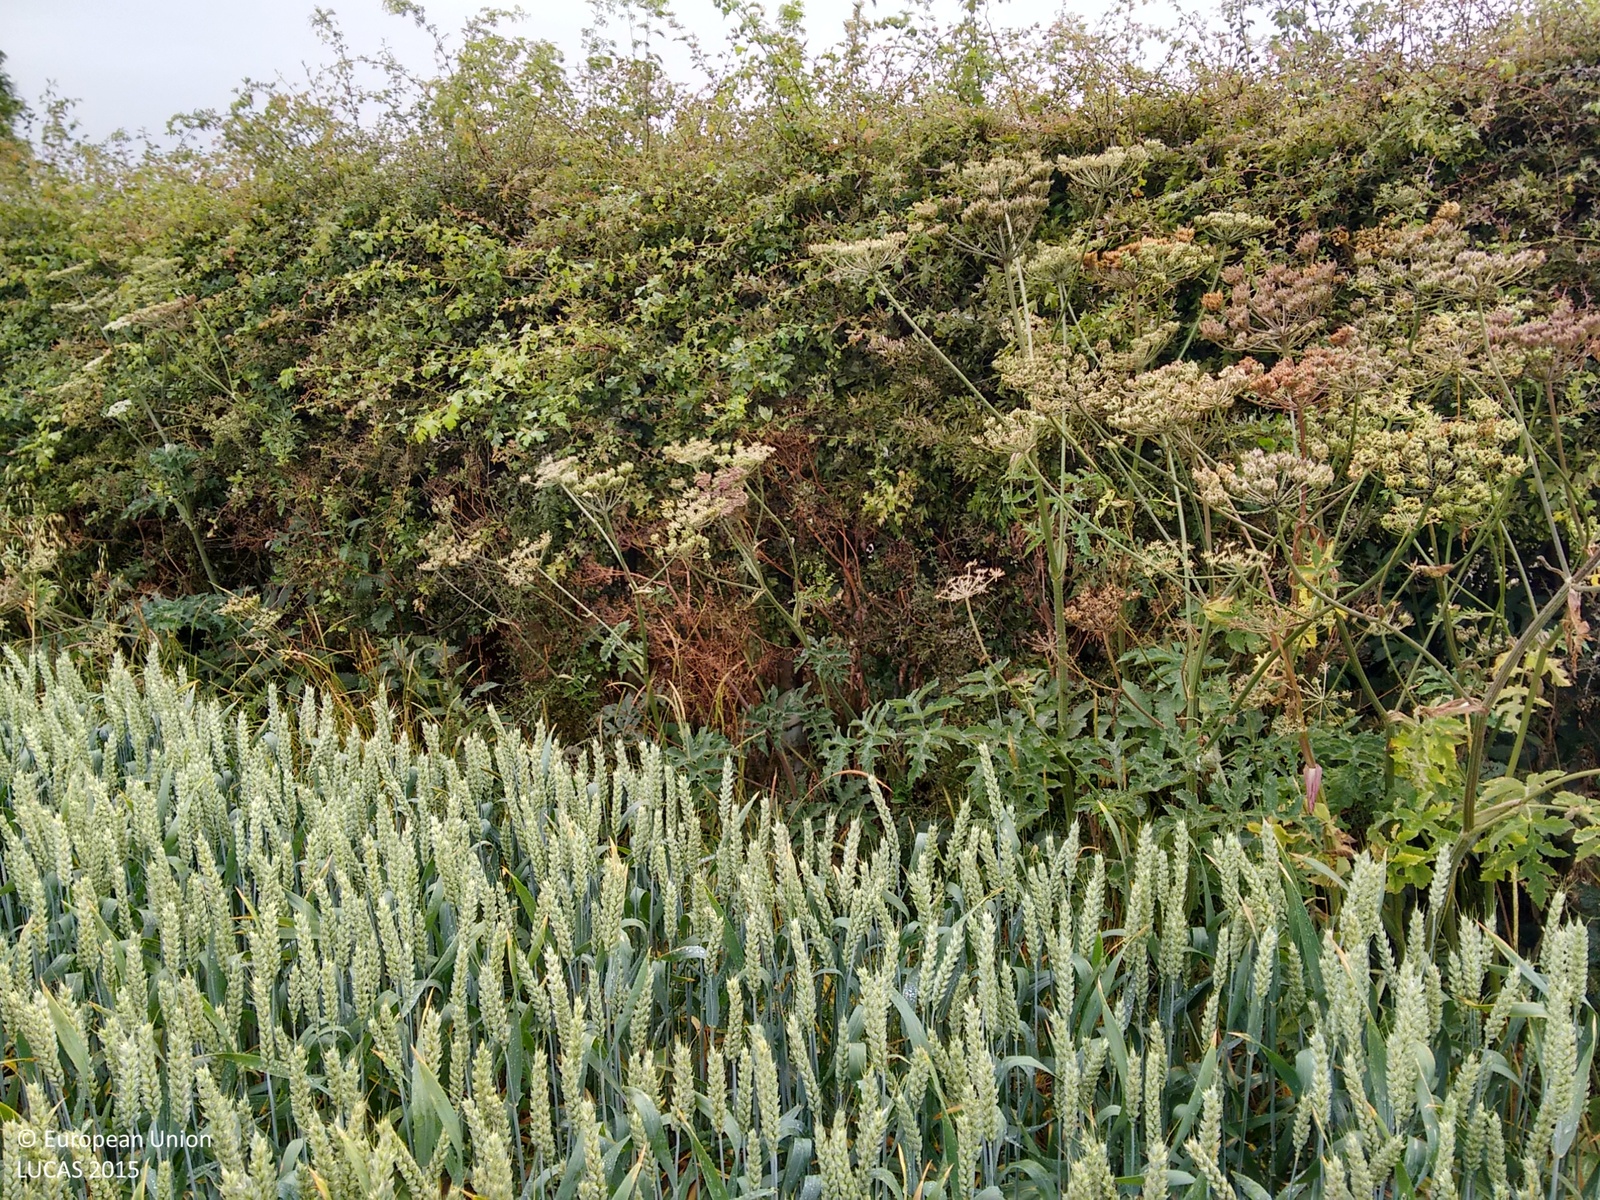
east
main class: Cropland
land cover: Common wheat
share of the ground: > 75 %
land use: Agriculture (excluding fallow land and kitchen gardens)
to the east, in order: Common wheat; Grass margins; Managed hedges; Grass margins; Tracks; Grass margins; Fences; Managed hedges; Grassland without tree/shrub cover; Broadleaved woodland; Grass margins; Arable land (only in case pi); Grass margins; Managed hedges; Arable land (only in case pi)
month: July
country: GB
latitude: 52.5302
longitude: -0.6682
